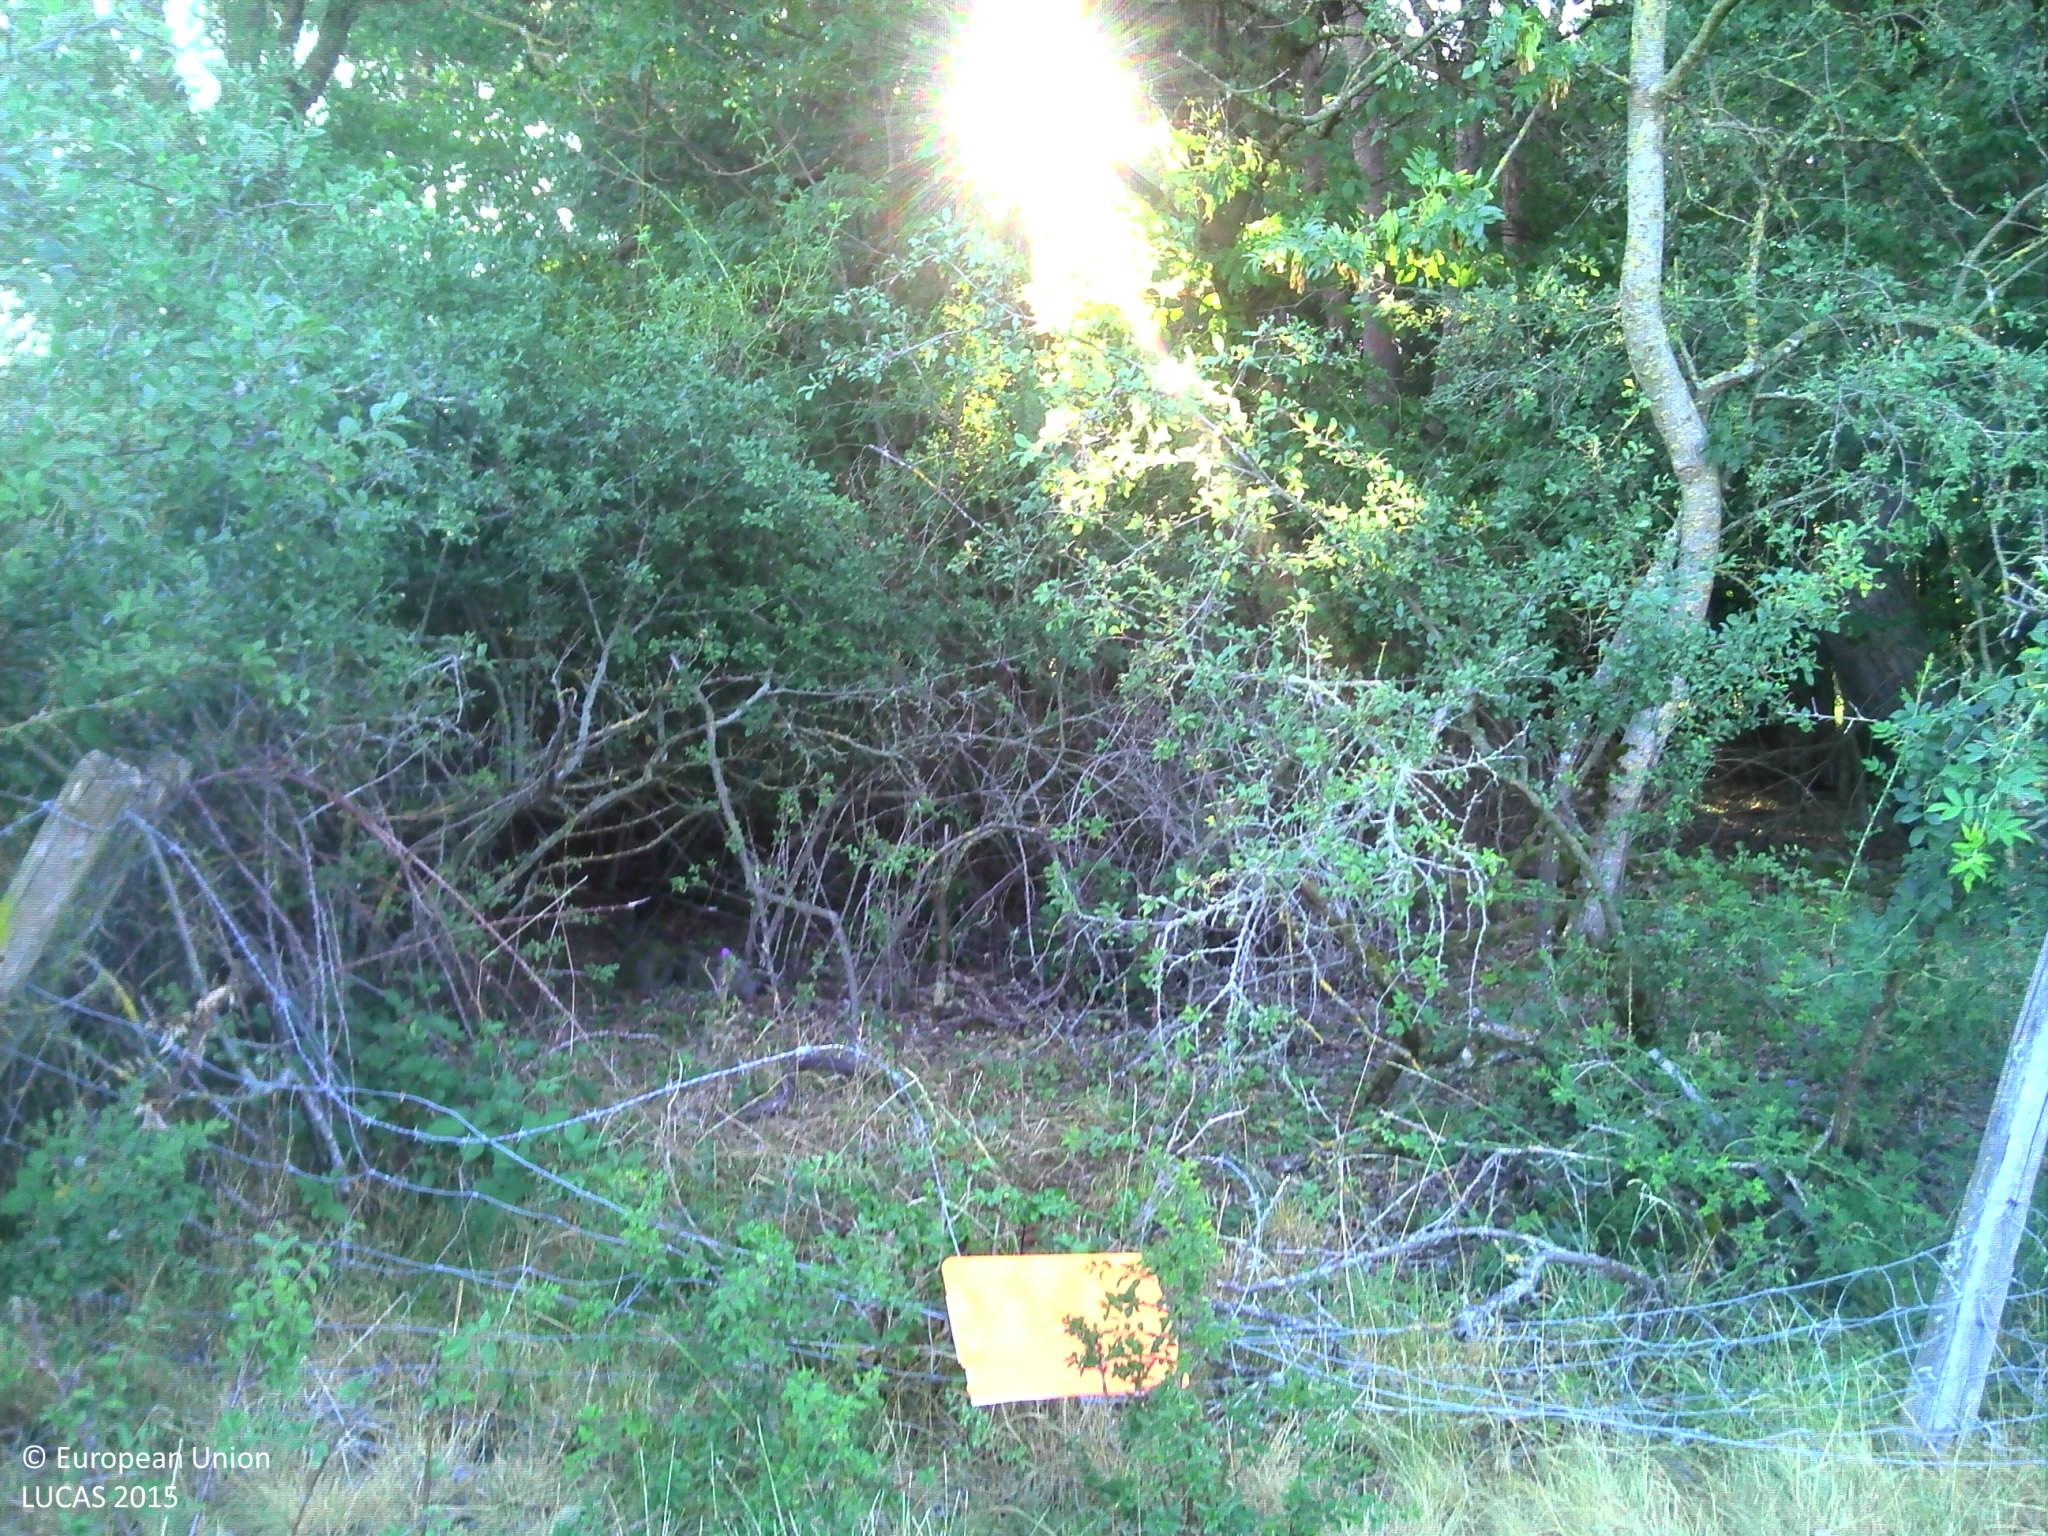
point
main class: Woodland
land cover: Pine dominated mixed woodland
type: acidophilous oak and oak-birch forest
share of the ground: > 75 %
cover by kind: coniferous forest trees 60 %, broadleaved forest trees 20 %, herbaceous plants 20 %
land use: Forestry
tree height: > 5 m
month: July
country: FR
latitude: 45.0882
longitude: 3.8164
